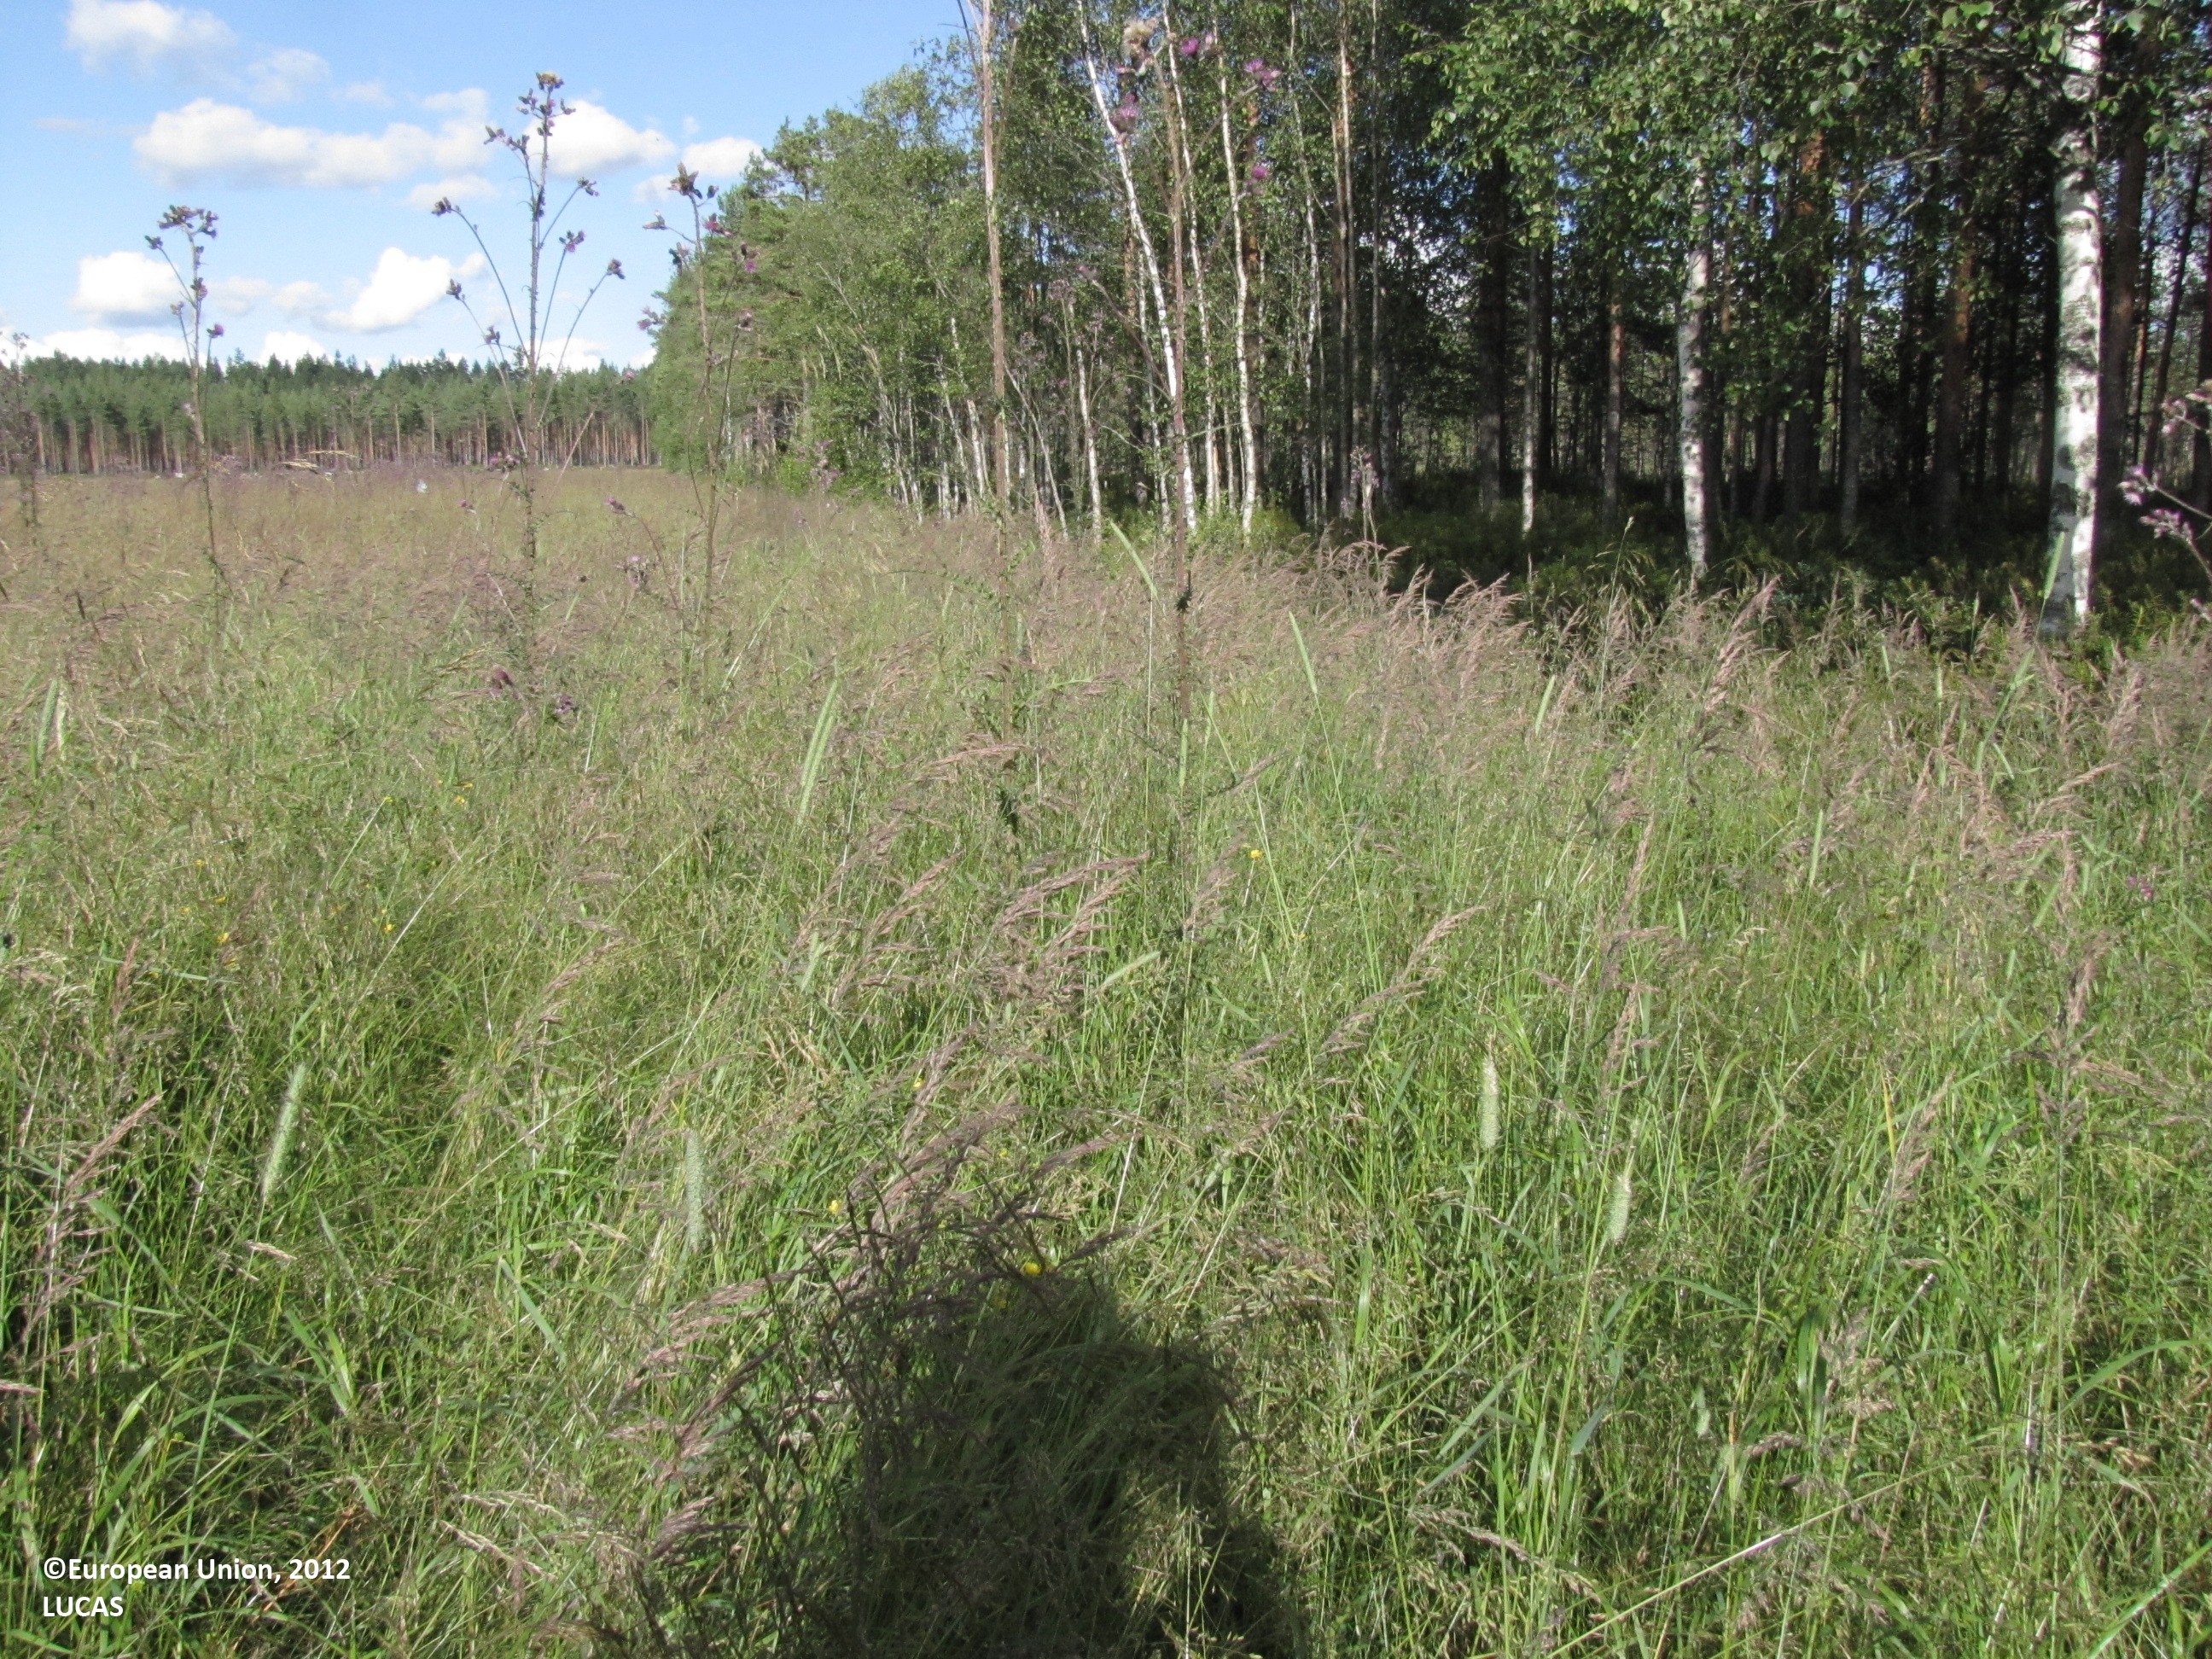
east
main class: Grassland
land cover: Grassland without tree/shrub cover
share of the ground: > 75 %
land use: Fallow land
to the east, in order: Grassland without tree/shrub cover; Ditches and canals; Pine dominated coniferous woodland; Ditches and canals; Pine dominated coniferous woodland; Ditches and canals; Pine dominated coniferous woodland; Ditches and canals; Pine dominated coniferous woodland; Ditches and canals; Pine dominated coniferous woodland; Ditches and canals; Pine dominated coniferous woodland; Ditches and canals; Pine dominated coniferous woodland
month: July
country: FI
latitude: 62.5356
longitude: 23.2637
